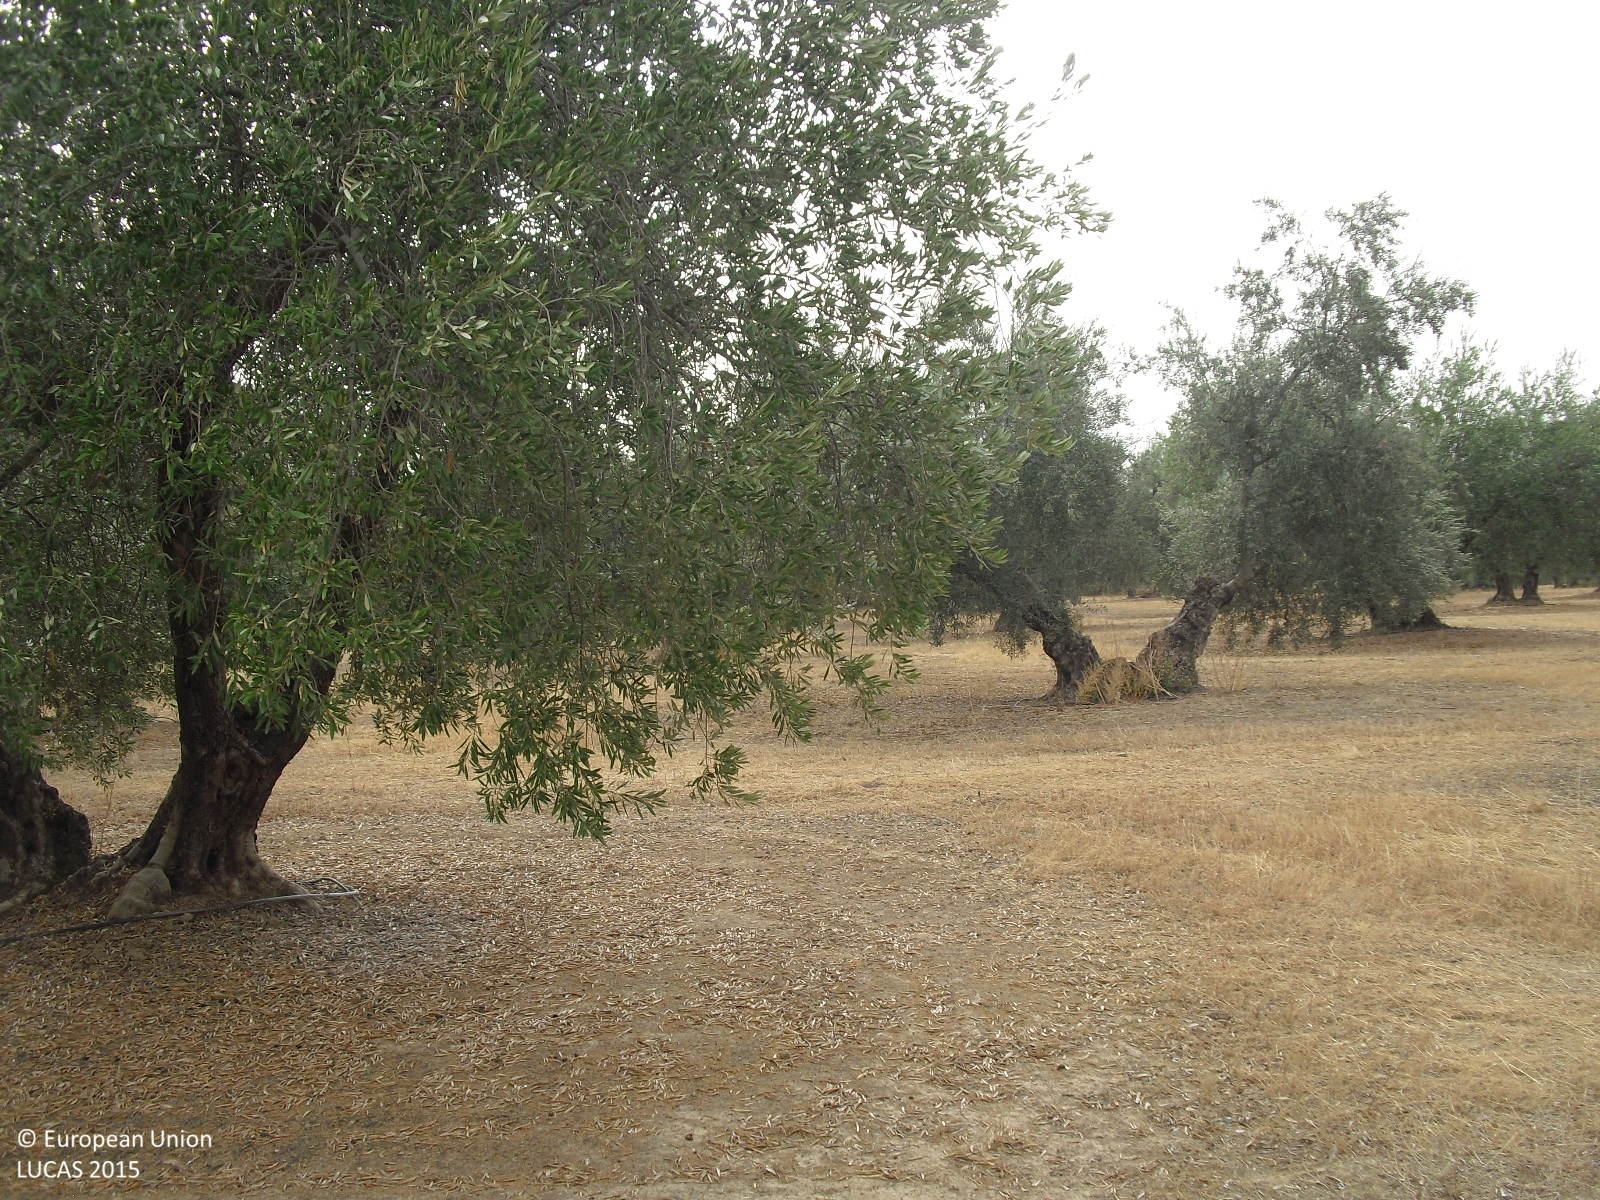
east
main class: Cropland
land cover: Olive groves
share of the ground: 25 - 50 %
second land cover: Spontaneously vegetated surfaces
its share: 25 - 50 %
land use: Agriculture (excluding fallow land and kitchen gardens)
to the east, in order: Olive groves; Spontaneously vegetated surfaces; Tracks; Olive groves; Tracks; Olive groves
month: August
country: ES
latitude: 37.1894
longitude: -4.0869
